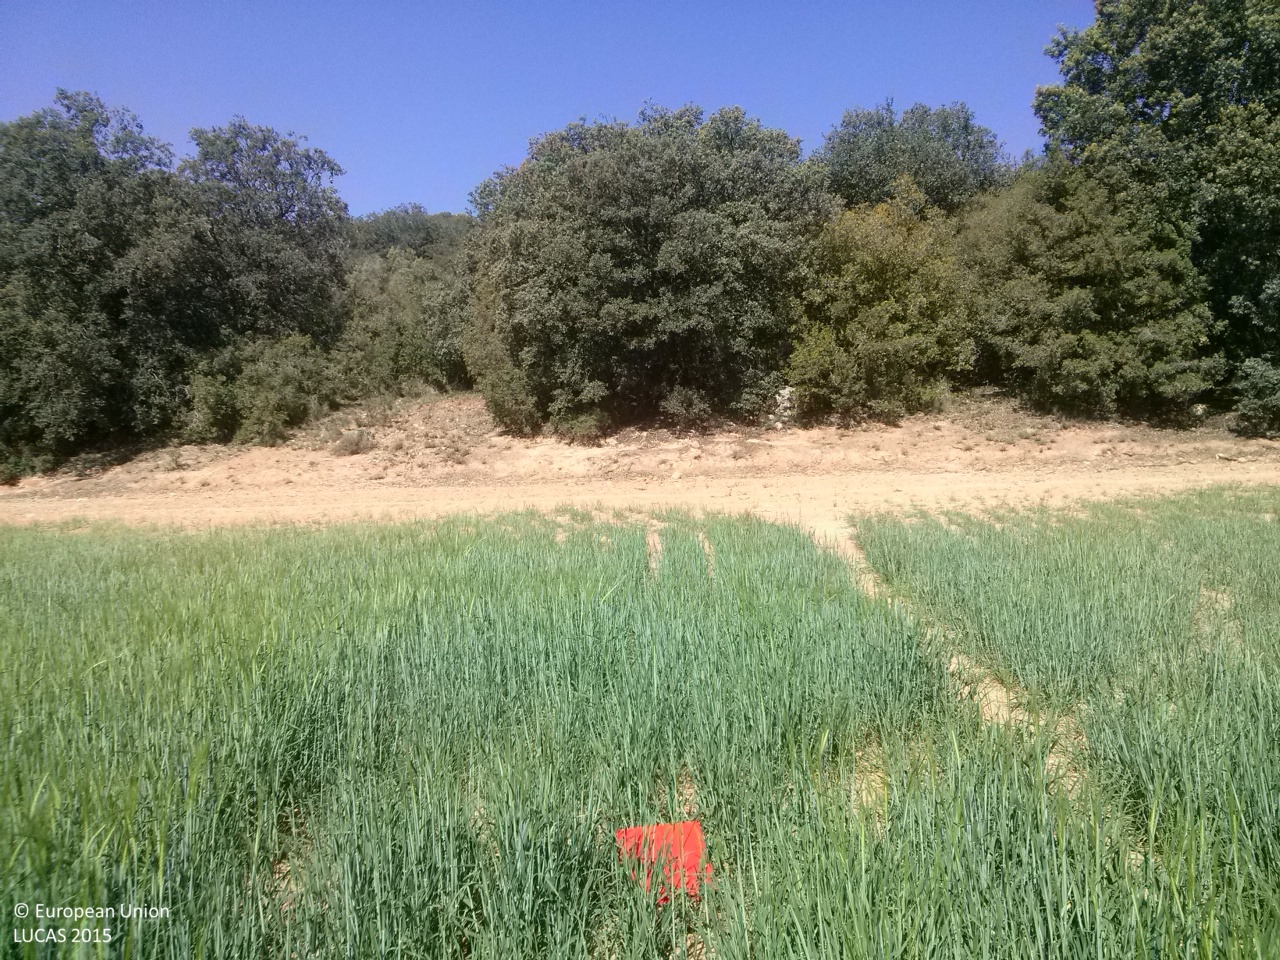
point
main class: Cropland
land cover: Barley
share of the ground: > 75 %
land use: Agriculture (excluding fallow land and kitchen gardens)
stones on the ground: 10 - 25 %
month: May
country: ES
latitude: 39.8616
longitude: -2.8201
